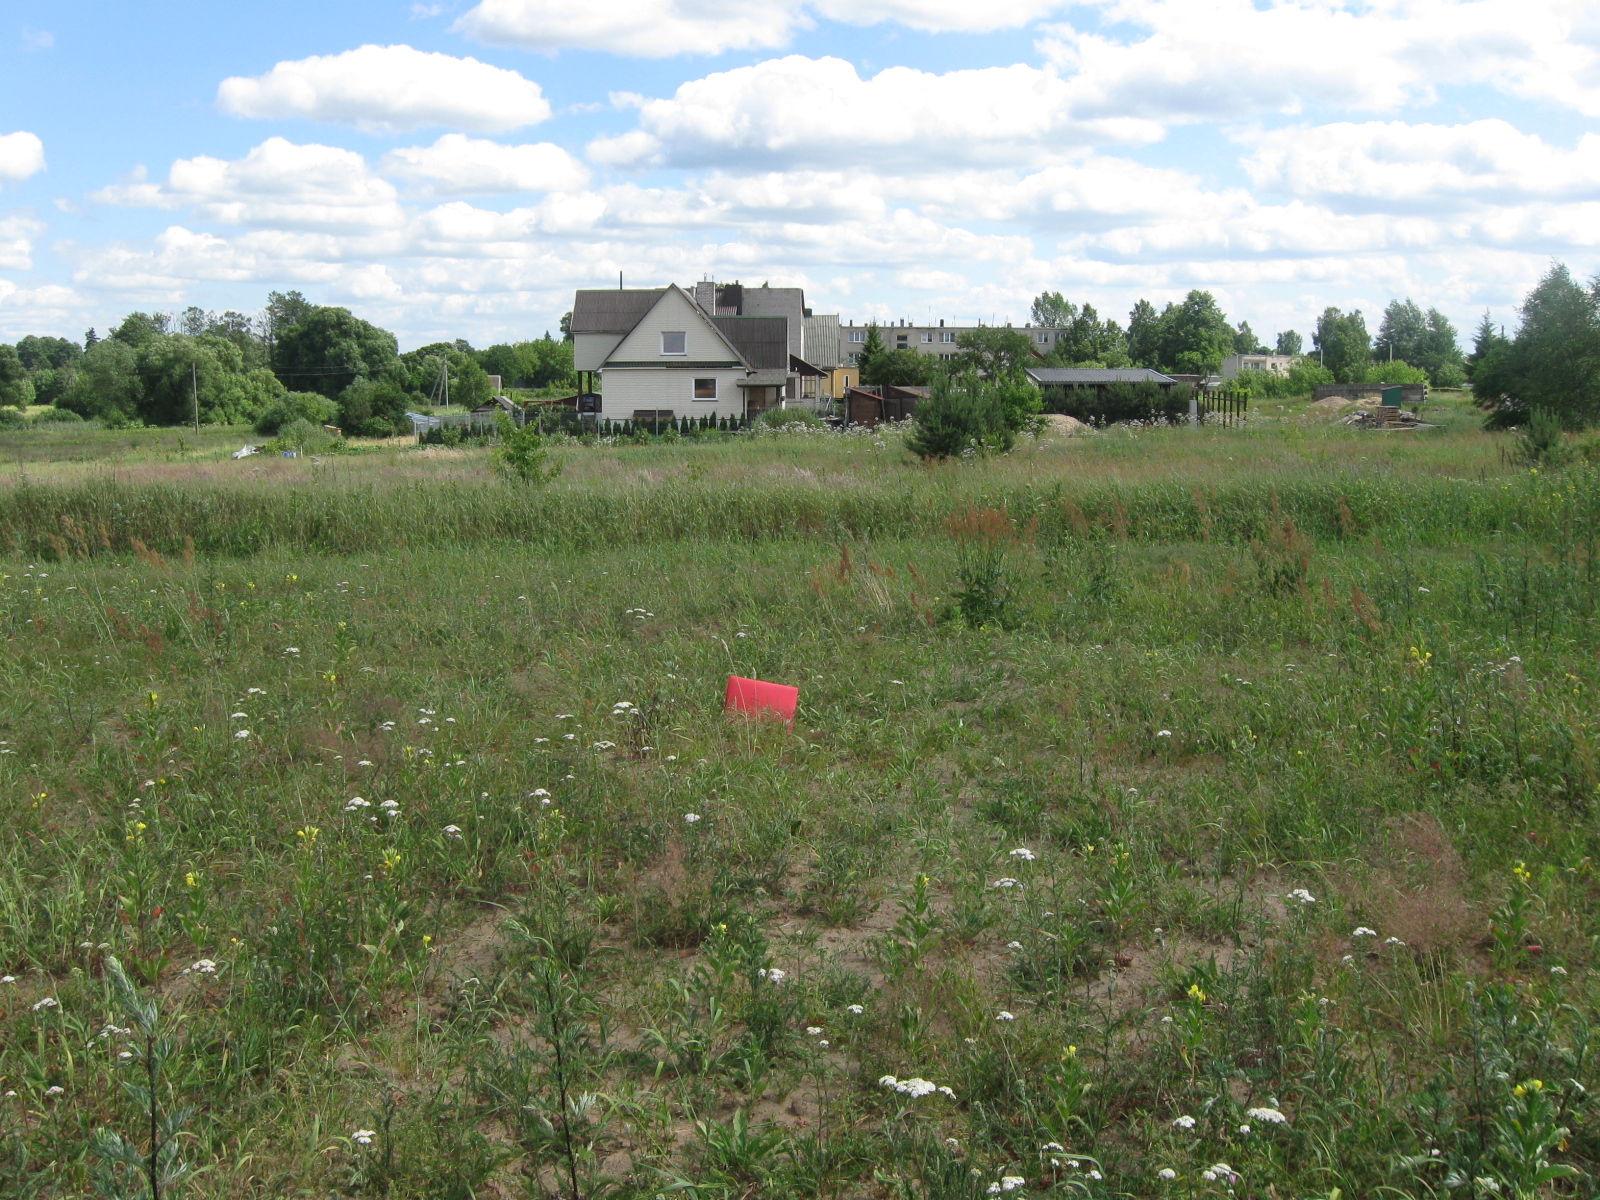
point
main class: Grassland
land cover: Spontaneously vegetated surfaces
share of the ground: > 75 %
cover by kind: herbaceous plants 75 %, unconsolidated bare surface 25 %
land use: Fallow land
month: June
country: LT
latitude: 54.2543
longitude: 24.5484
